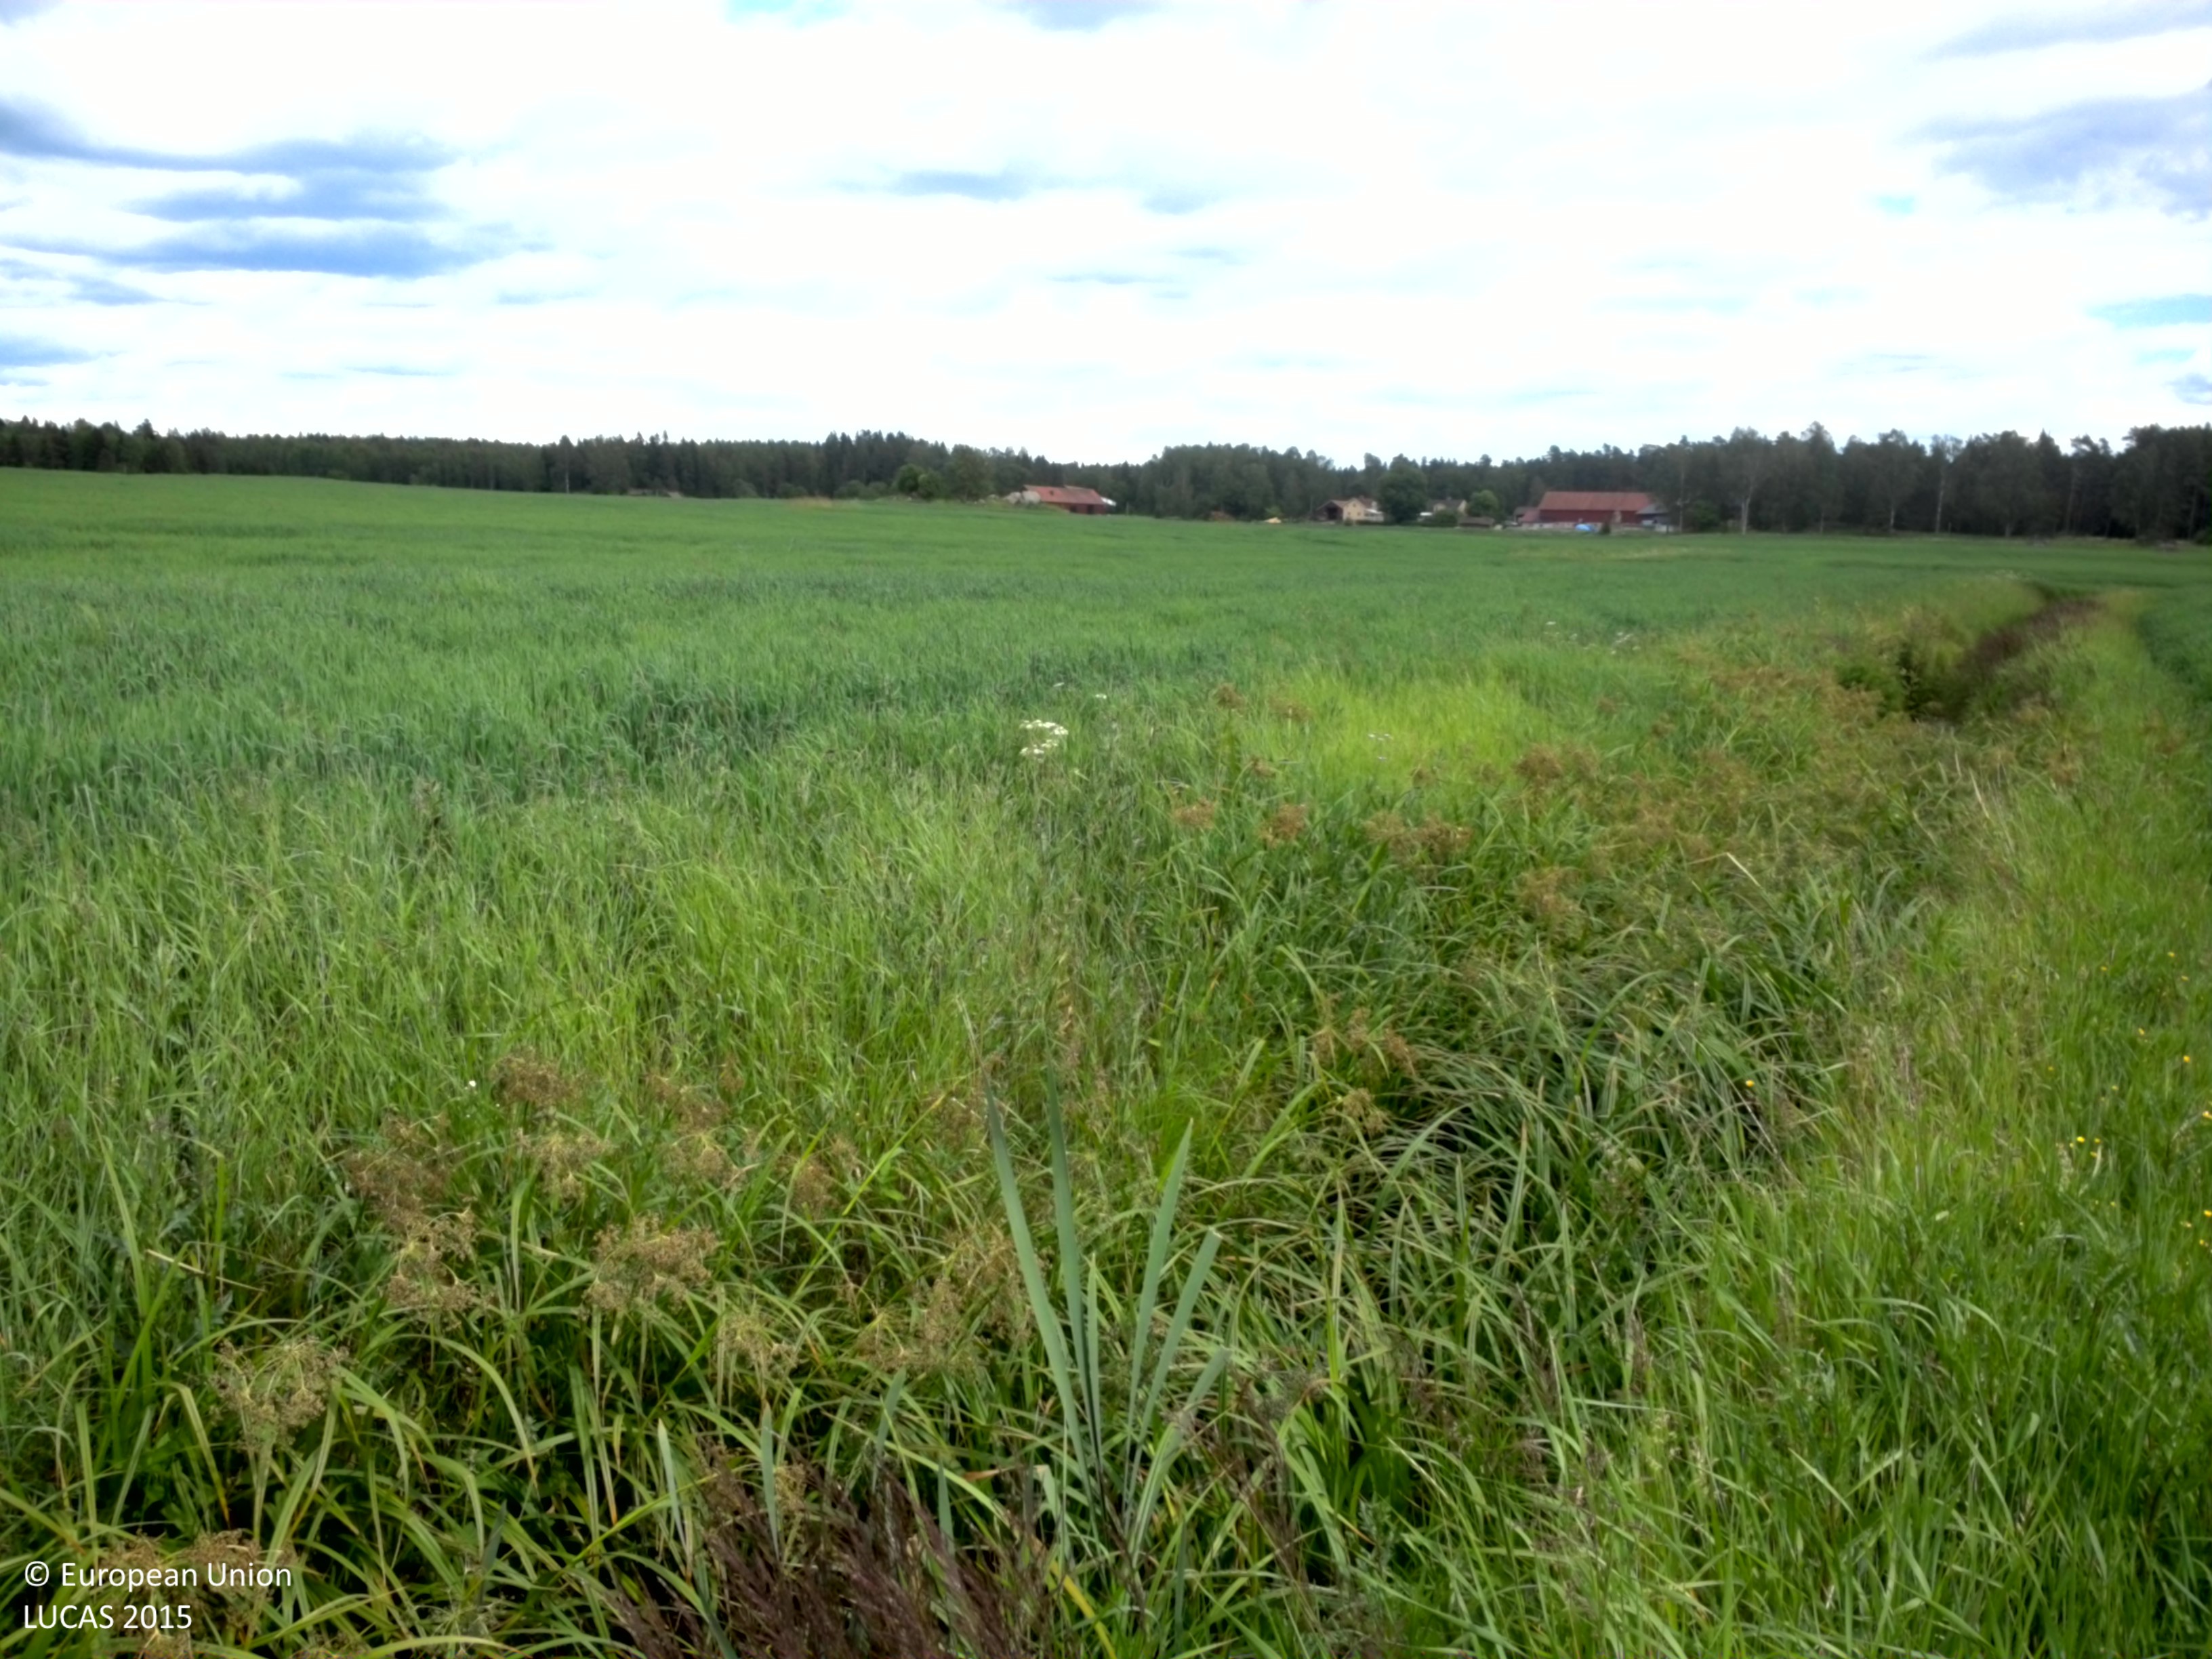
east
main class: Cropland
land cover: Oats
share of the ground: > 75 %
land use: Agriculture (excluding fallow land and kitchen gardens)
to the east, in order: Grass margins; Ditches and canals; Grass margins; Oats; Grassland with sparse tree/shrub cover; Oats
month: July
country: SE
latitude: 60.0263
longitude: 16.9719
